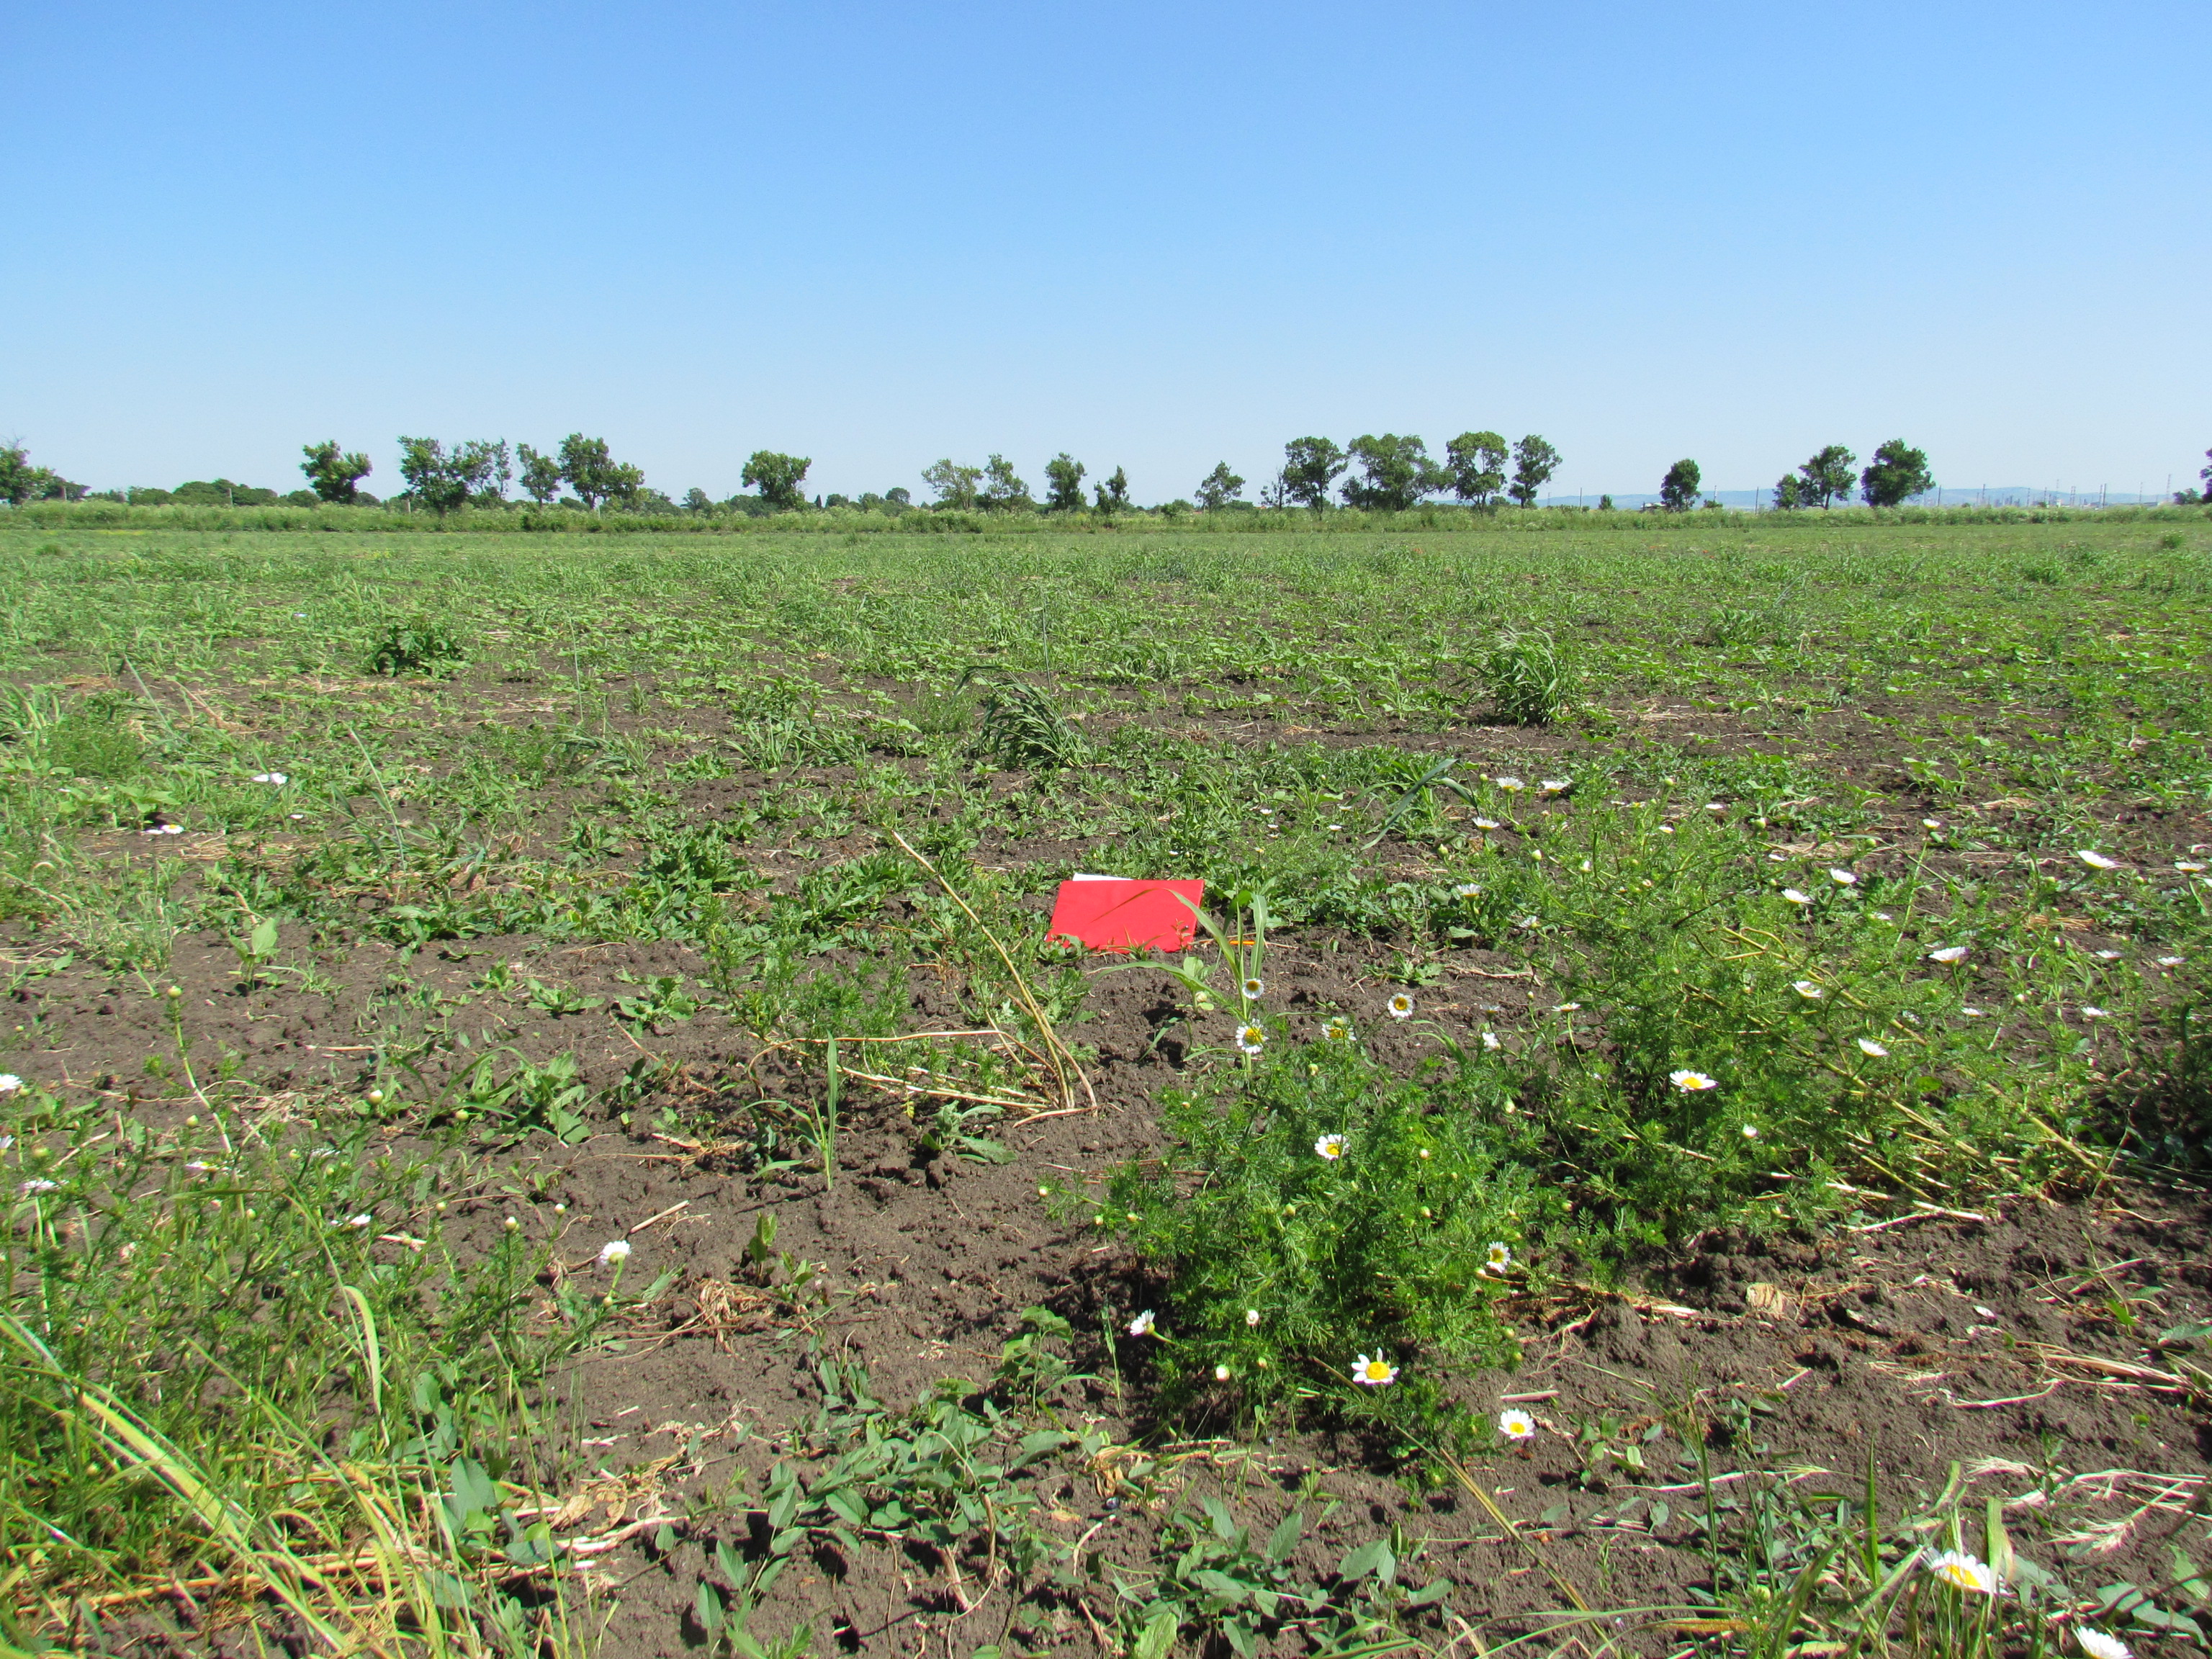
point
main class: Cropland
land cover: Sunflower
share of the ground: 10 - 25 %
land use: Agriculture (excluding fallow land and kitchen gardens)
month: June
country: BG
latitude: 42.4961
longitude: 27.3056
